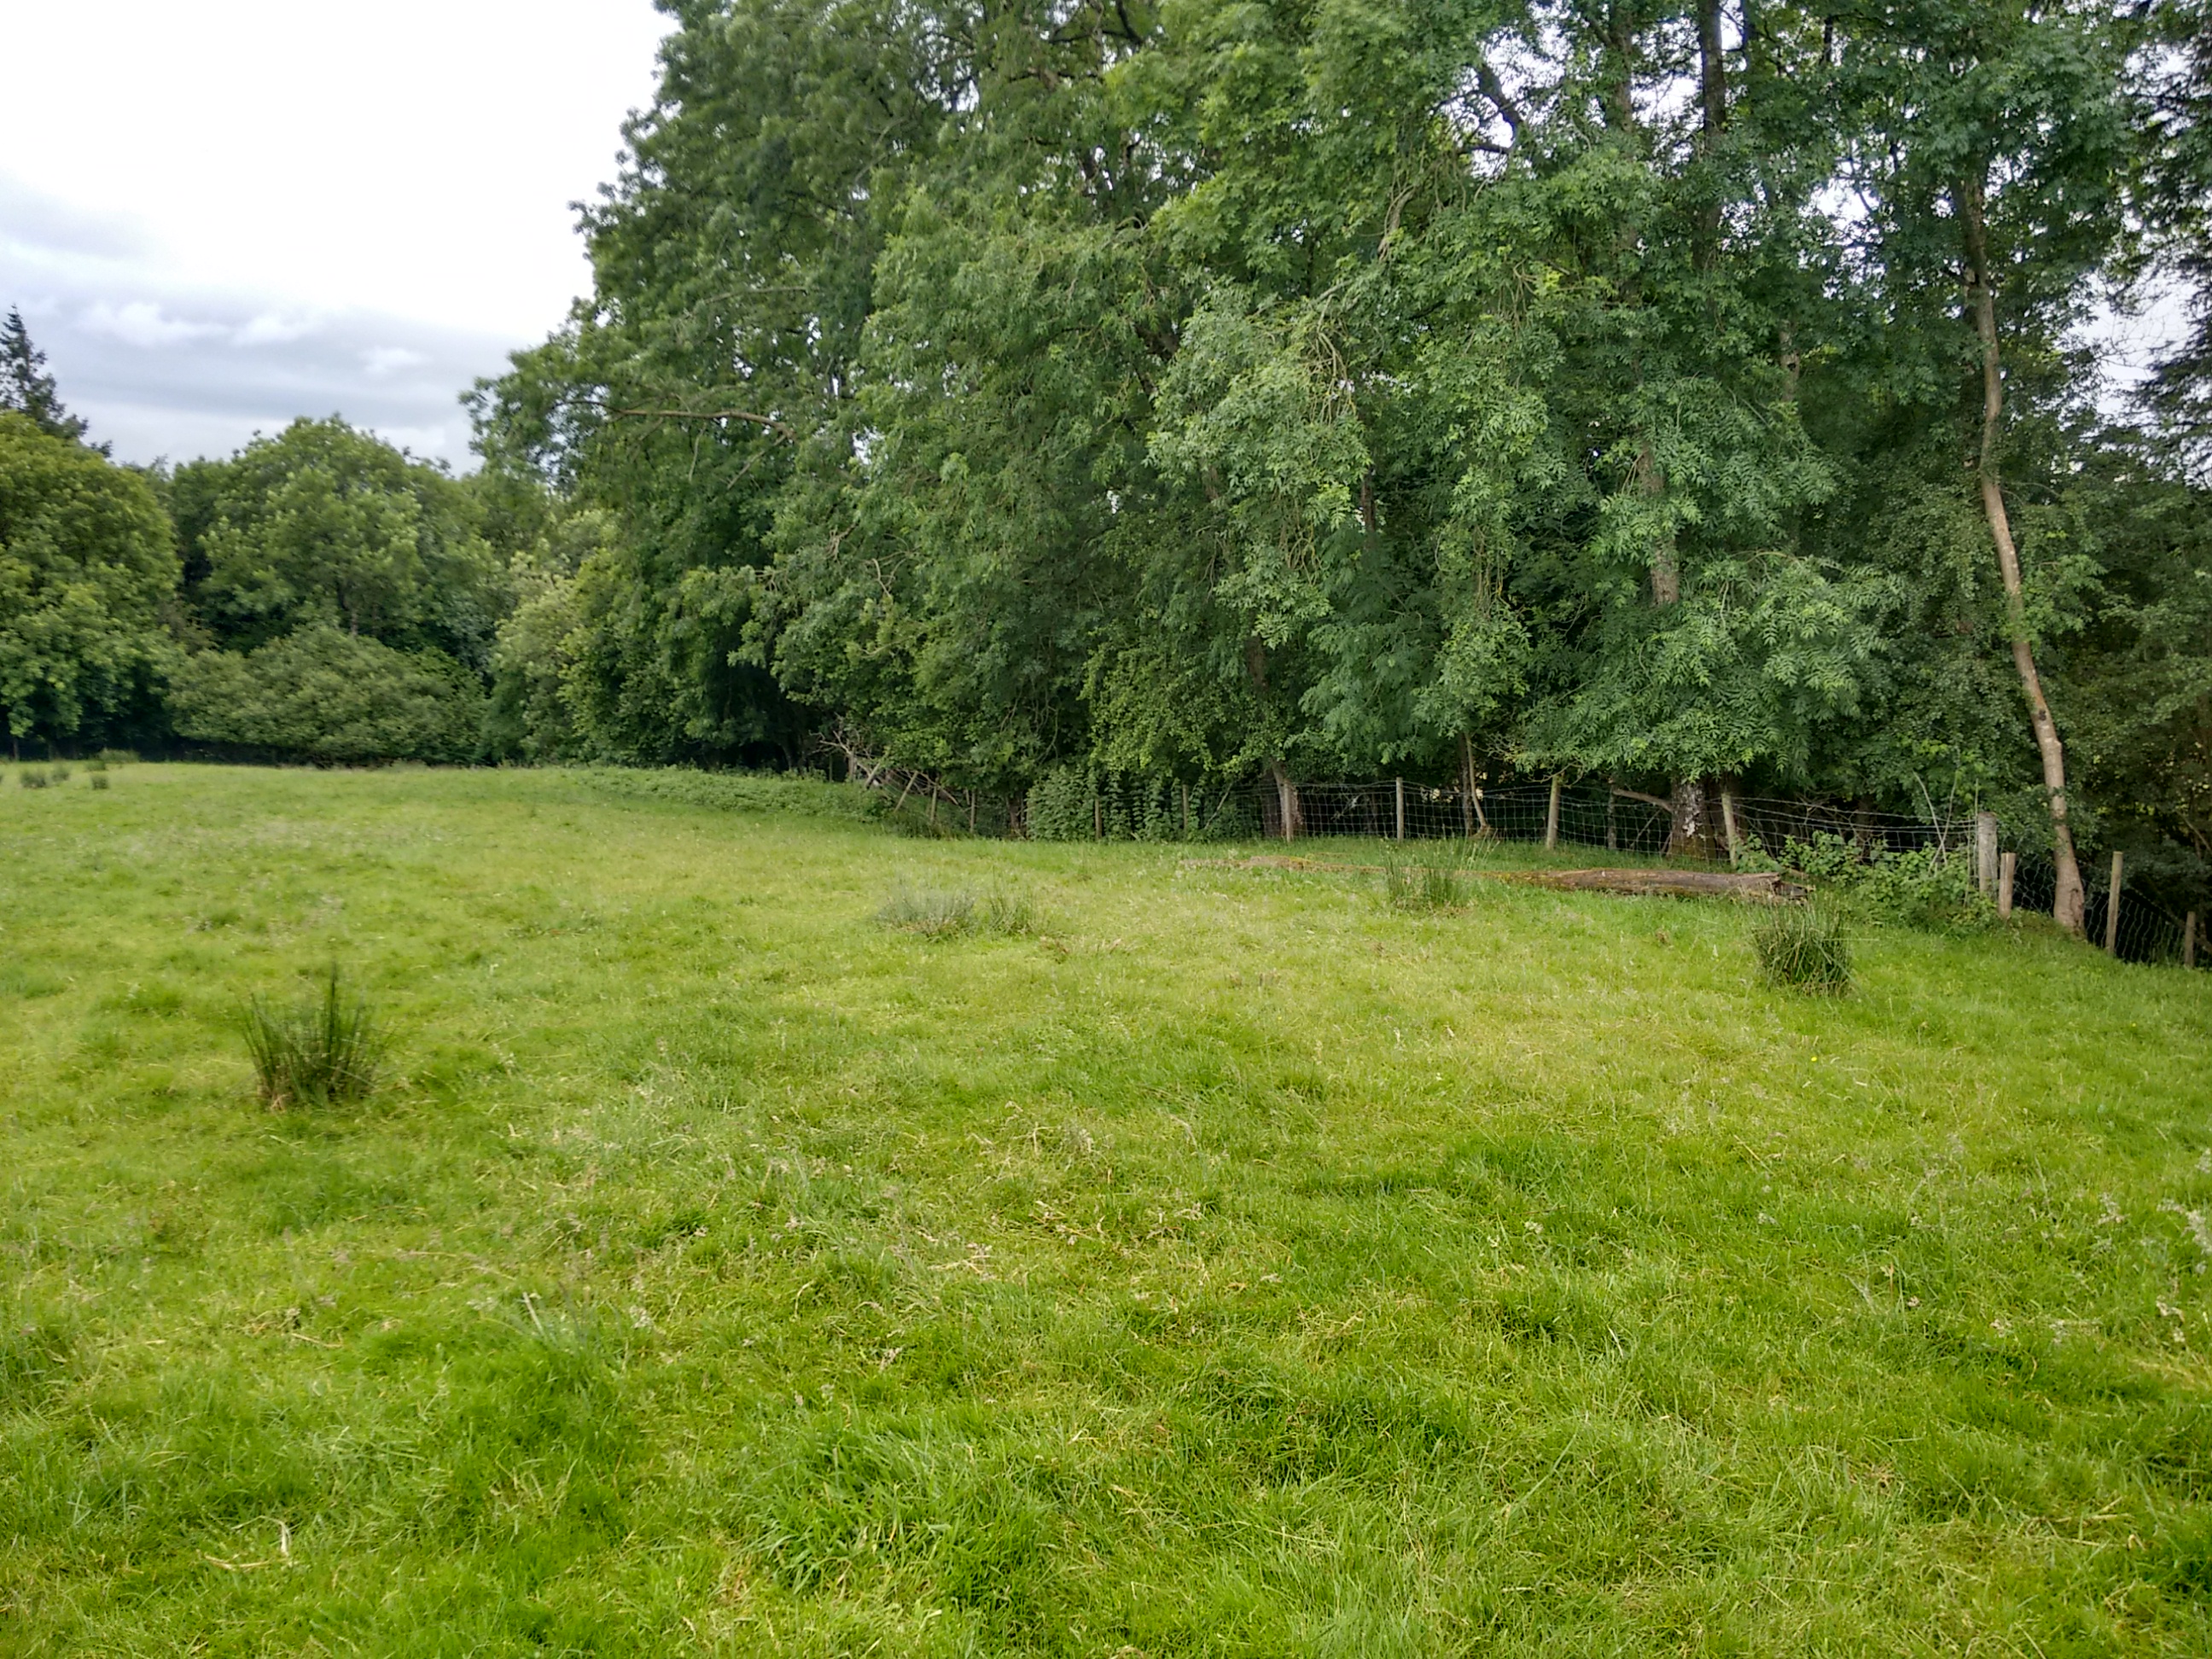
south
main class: Grassland
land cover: Grassland without tree/shrub cover
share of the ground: > 75 %
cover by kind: herbaceous plants 100 %
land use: Agriculture (excluding fallow land and kitchen gardens)
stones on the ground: 10 - 25 %
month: July
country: GB
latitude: 54.7632
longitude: -6.8730
